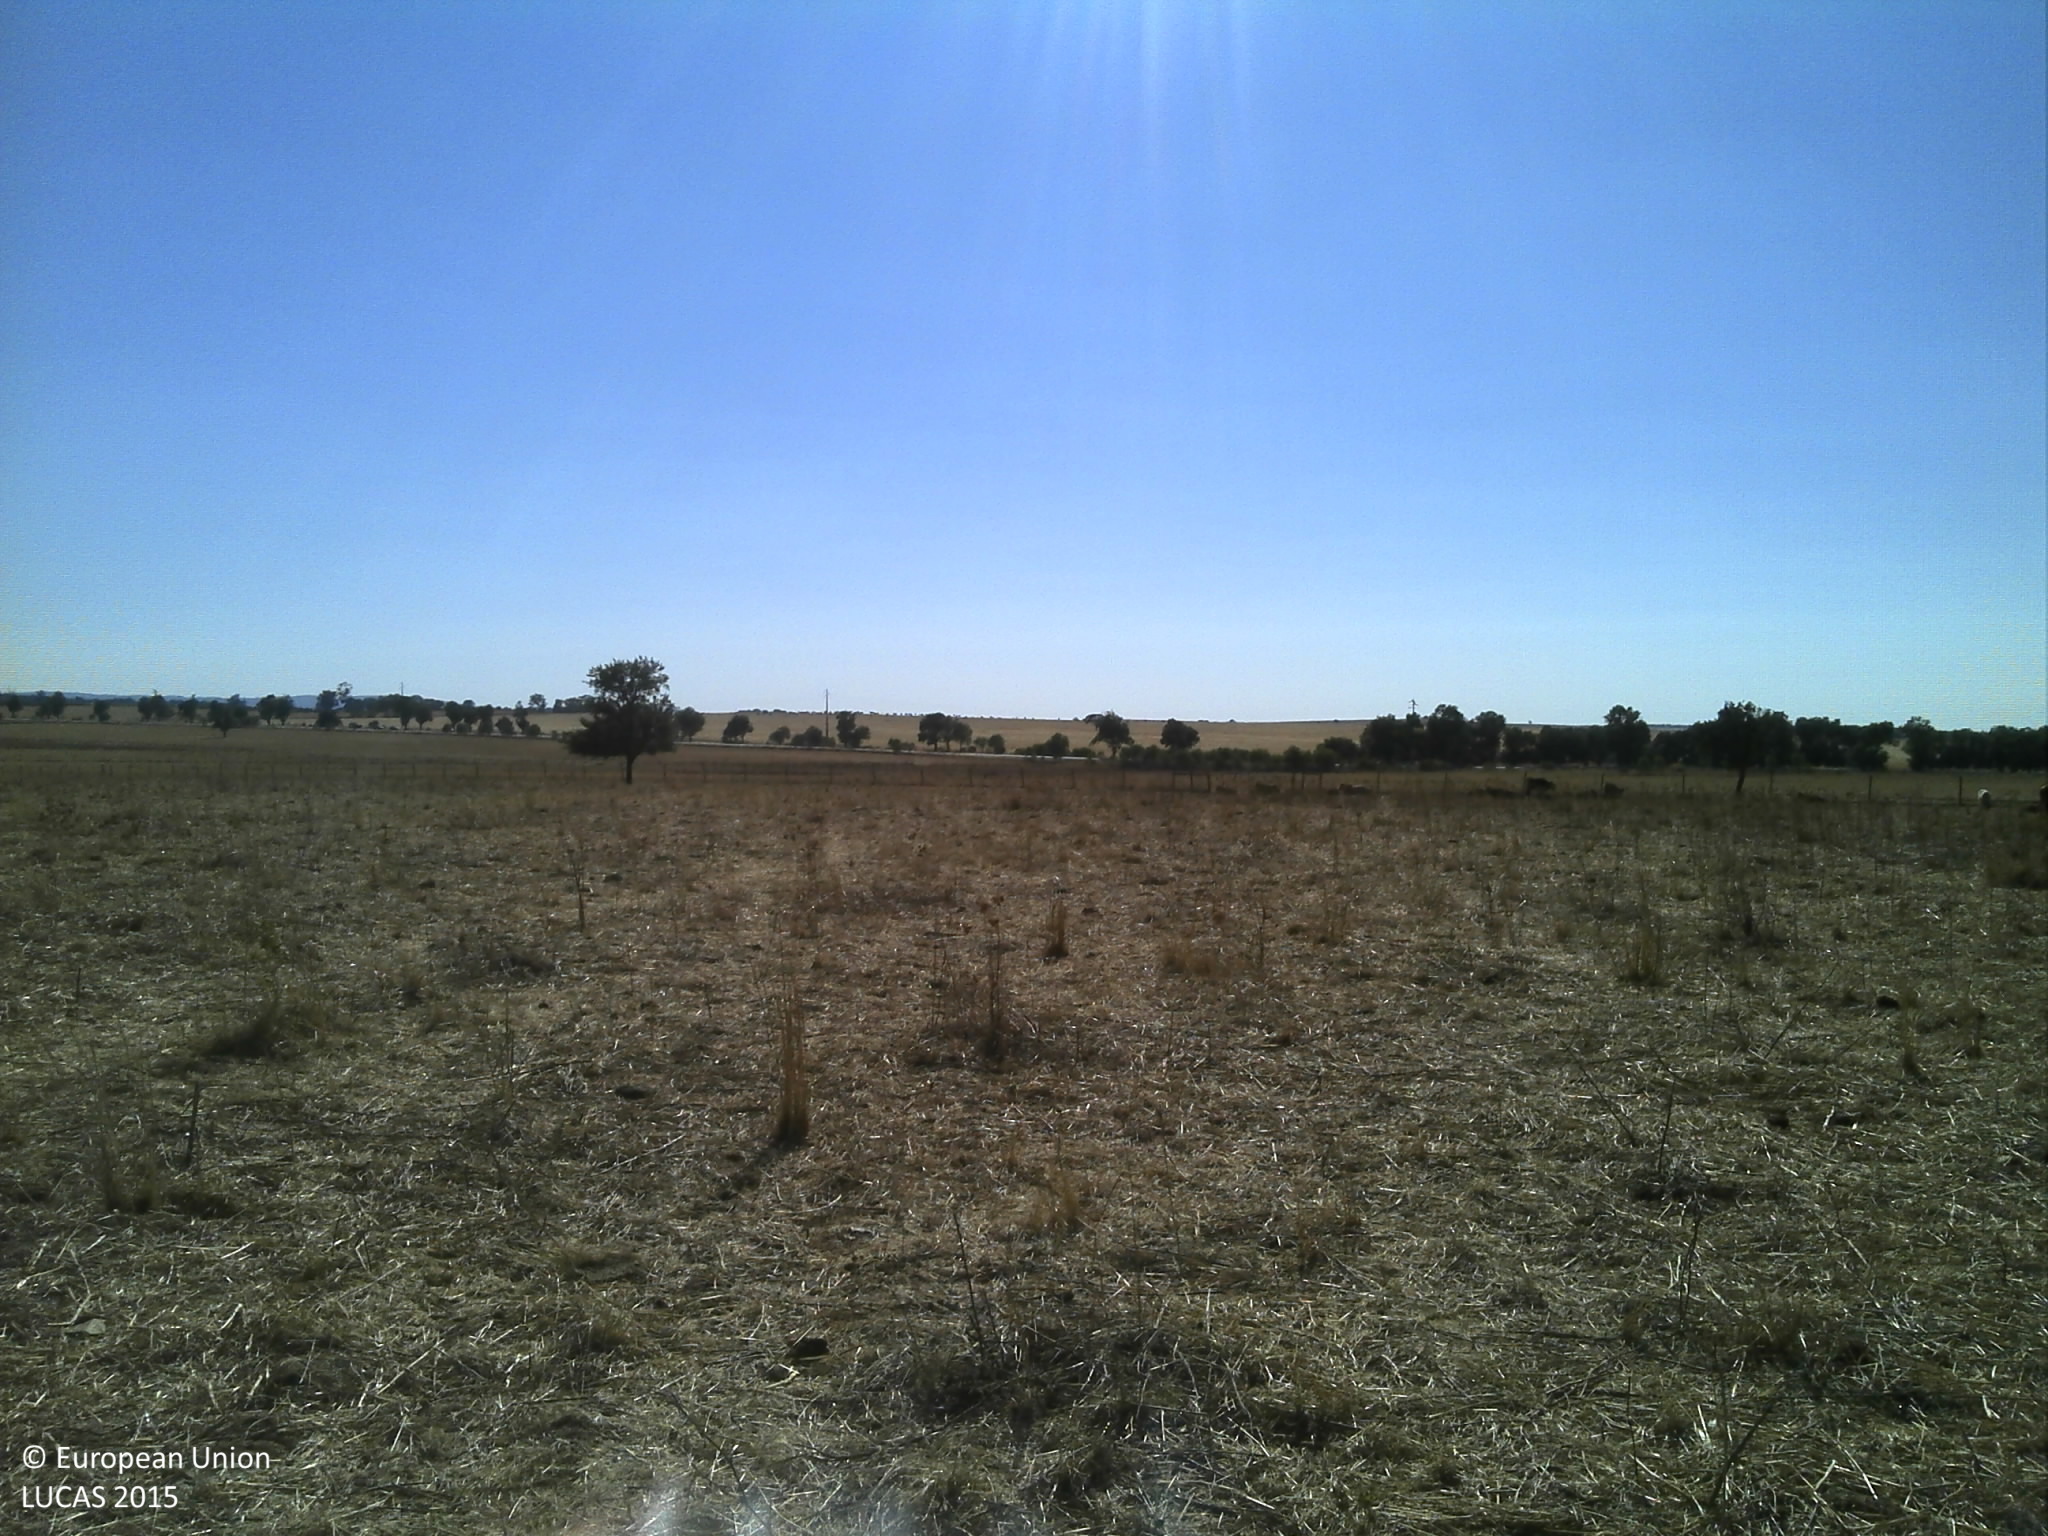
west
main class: Grassland
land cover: Grassland without tree/shrub cover
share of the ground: 10 - 25 %
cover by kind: unconsolidated bare surface 80 %, herbaceous plants 20 %
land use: Agriculture (excluding fallow land and kitchen gardens)
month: July
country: PT
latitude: 38.9799
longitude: -7.4790
